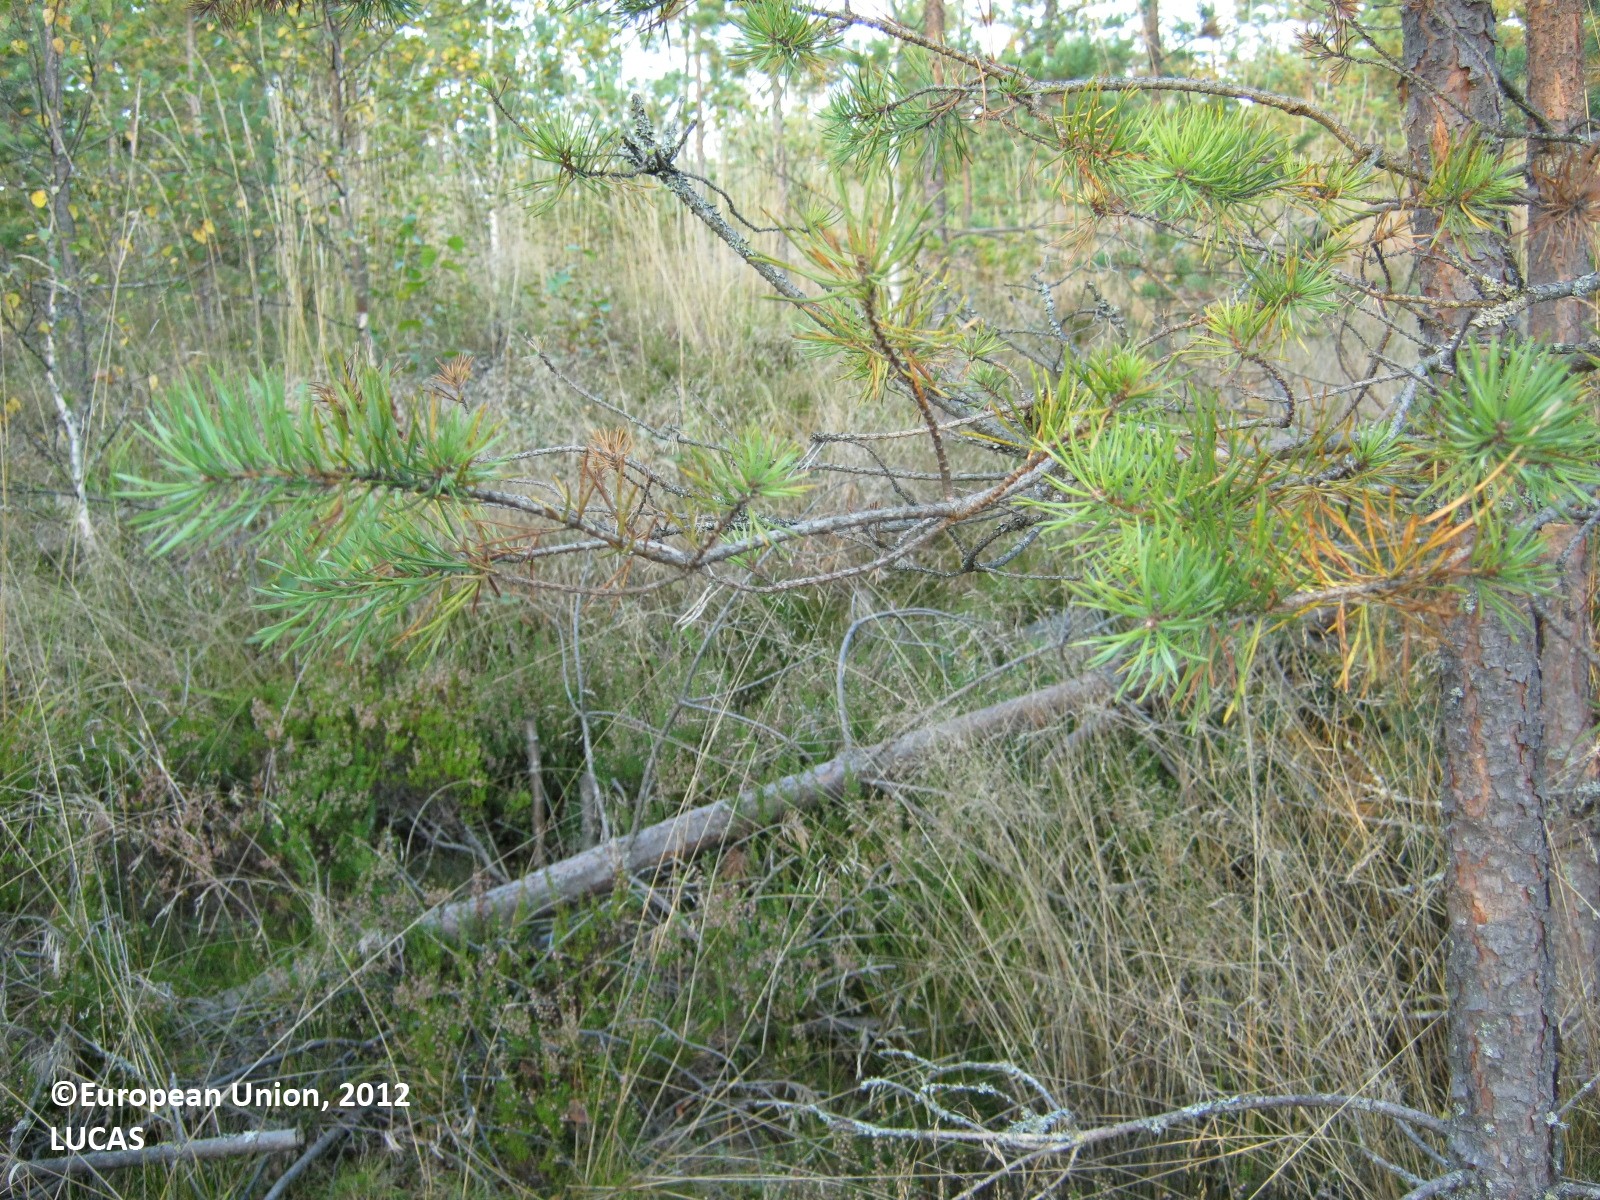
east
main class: Woodland
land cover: Pine dominated coniferous woodland
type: boreal forest
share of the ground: > 75 %
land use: Forestry
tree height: < 5 m
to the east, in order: Pine dominated coniferous woodland; Tracks; Pine dominated mixed woodland; Tracks; Other mixed woodland; Shrubland with sparse tree cover
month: September
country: FI
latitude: 60.7750
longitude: 27.9547
